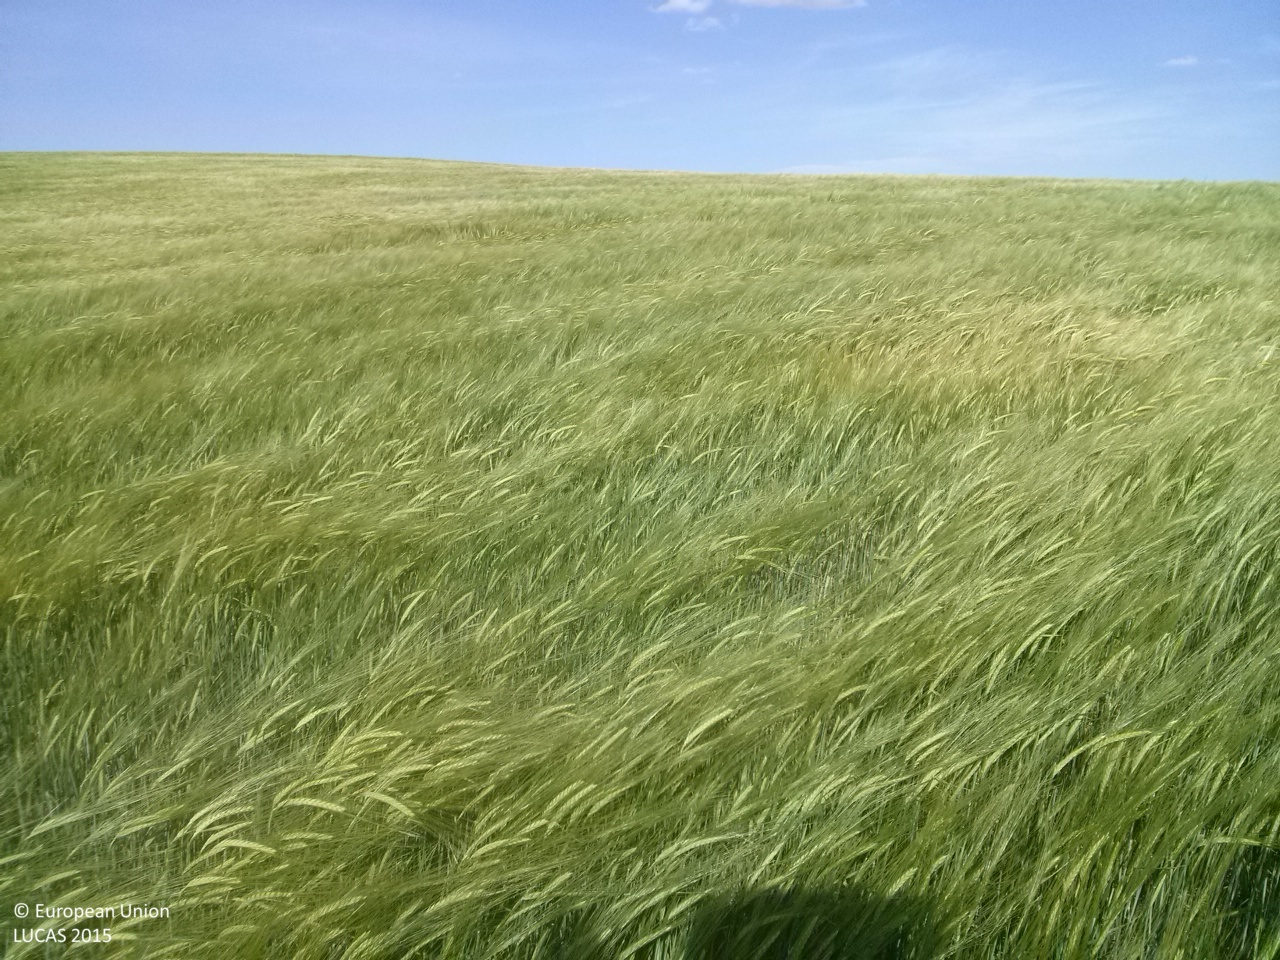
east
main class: Cropland
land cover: Barley
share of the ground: > 75 %
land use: Agriculture (excluding fallow land and kitchen gardens)
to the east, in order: Barley; Broadleaved woodland
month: May
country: ES
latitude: 40.0966
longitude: -2.7015
